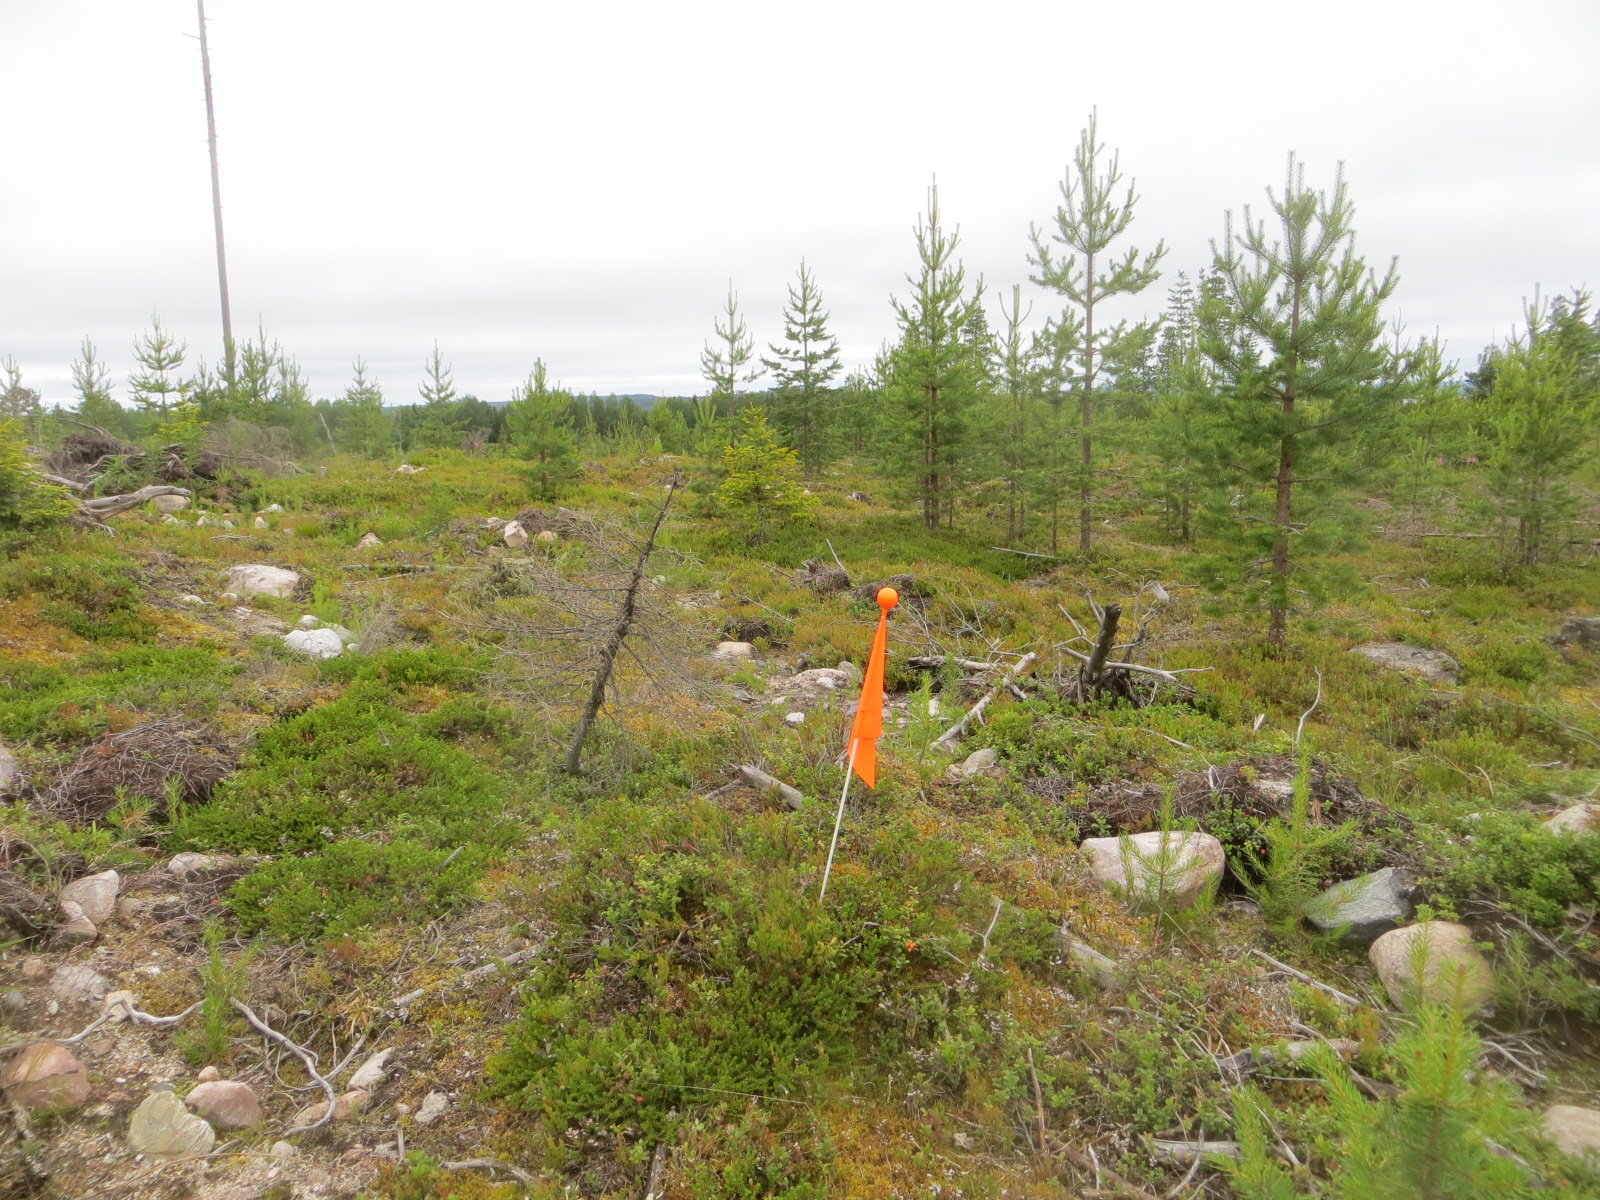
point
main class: Woodland
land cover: Pine dominated coniferous woodland
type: boreal forest
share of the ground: 25 - 50 %
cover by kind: shrubs 70 %, coniferous forest trees 25 %, broadleaved forest trees 5 %
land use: Forestry
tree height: < 5 m
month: July
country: FI
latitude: 66.4296
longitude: 24.4093
